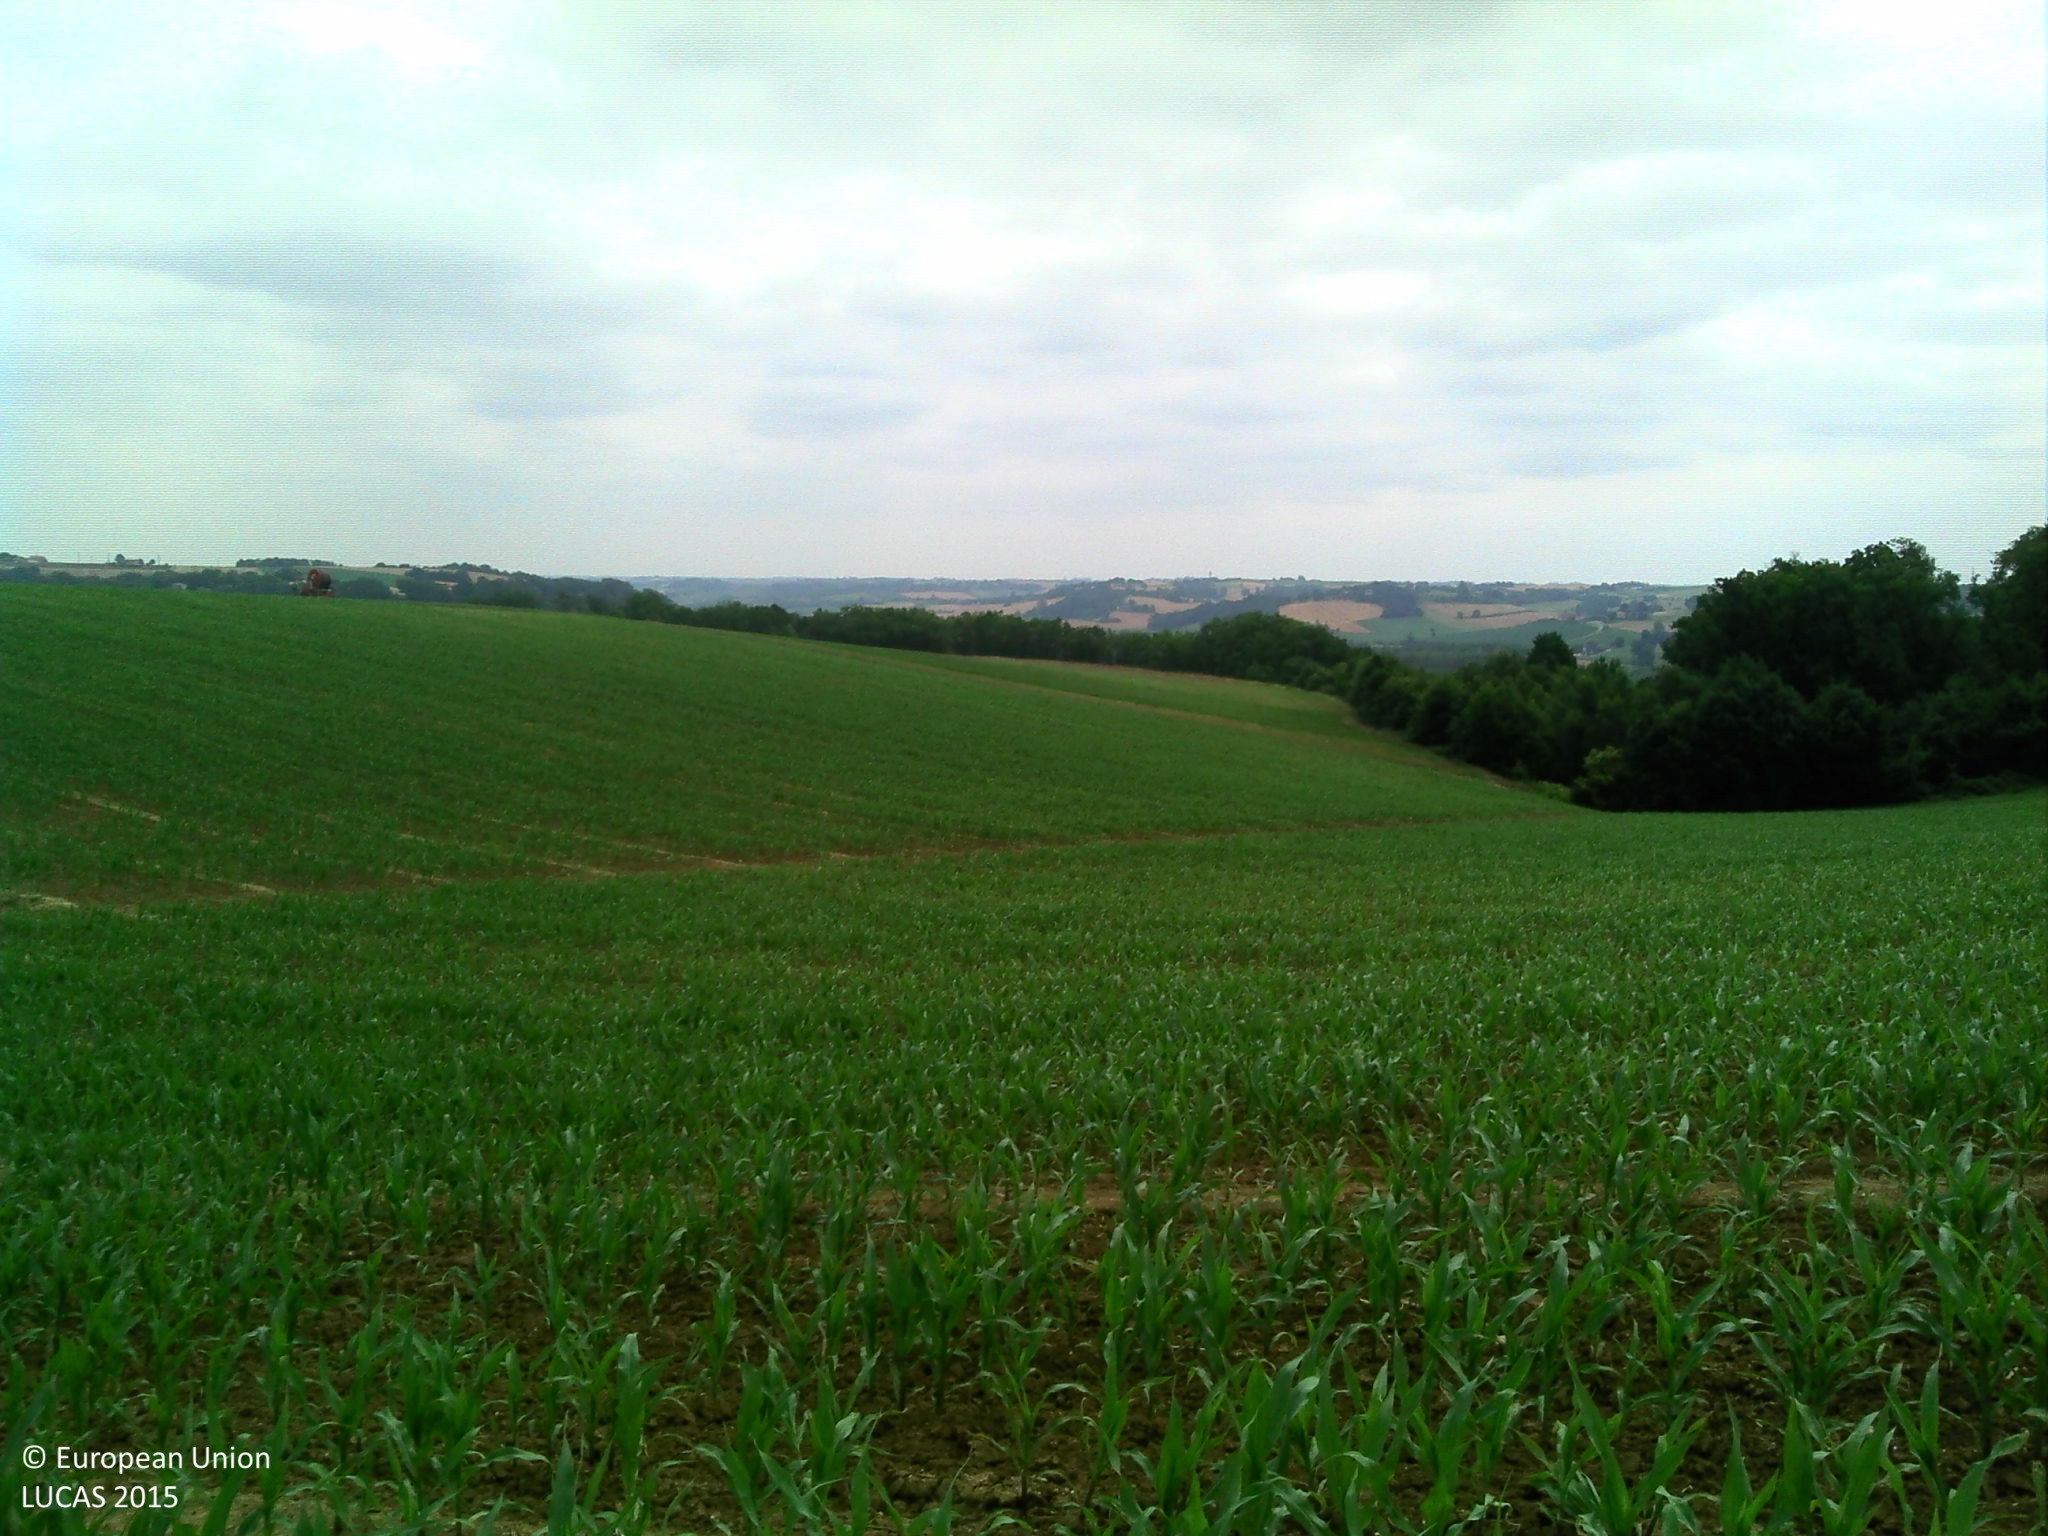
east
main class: Cropland
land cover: Maize
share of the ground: > 75 %
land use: Agriculture (excluding fallow land and kitchen gardens)
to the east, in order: Maize; Lucerne
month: June
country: FR
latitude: 44.1323
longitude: 0.9103
